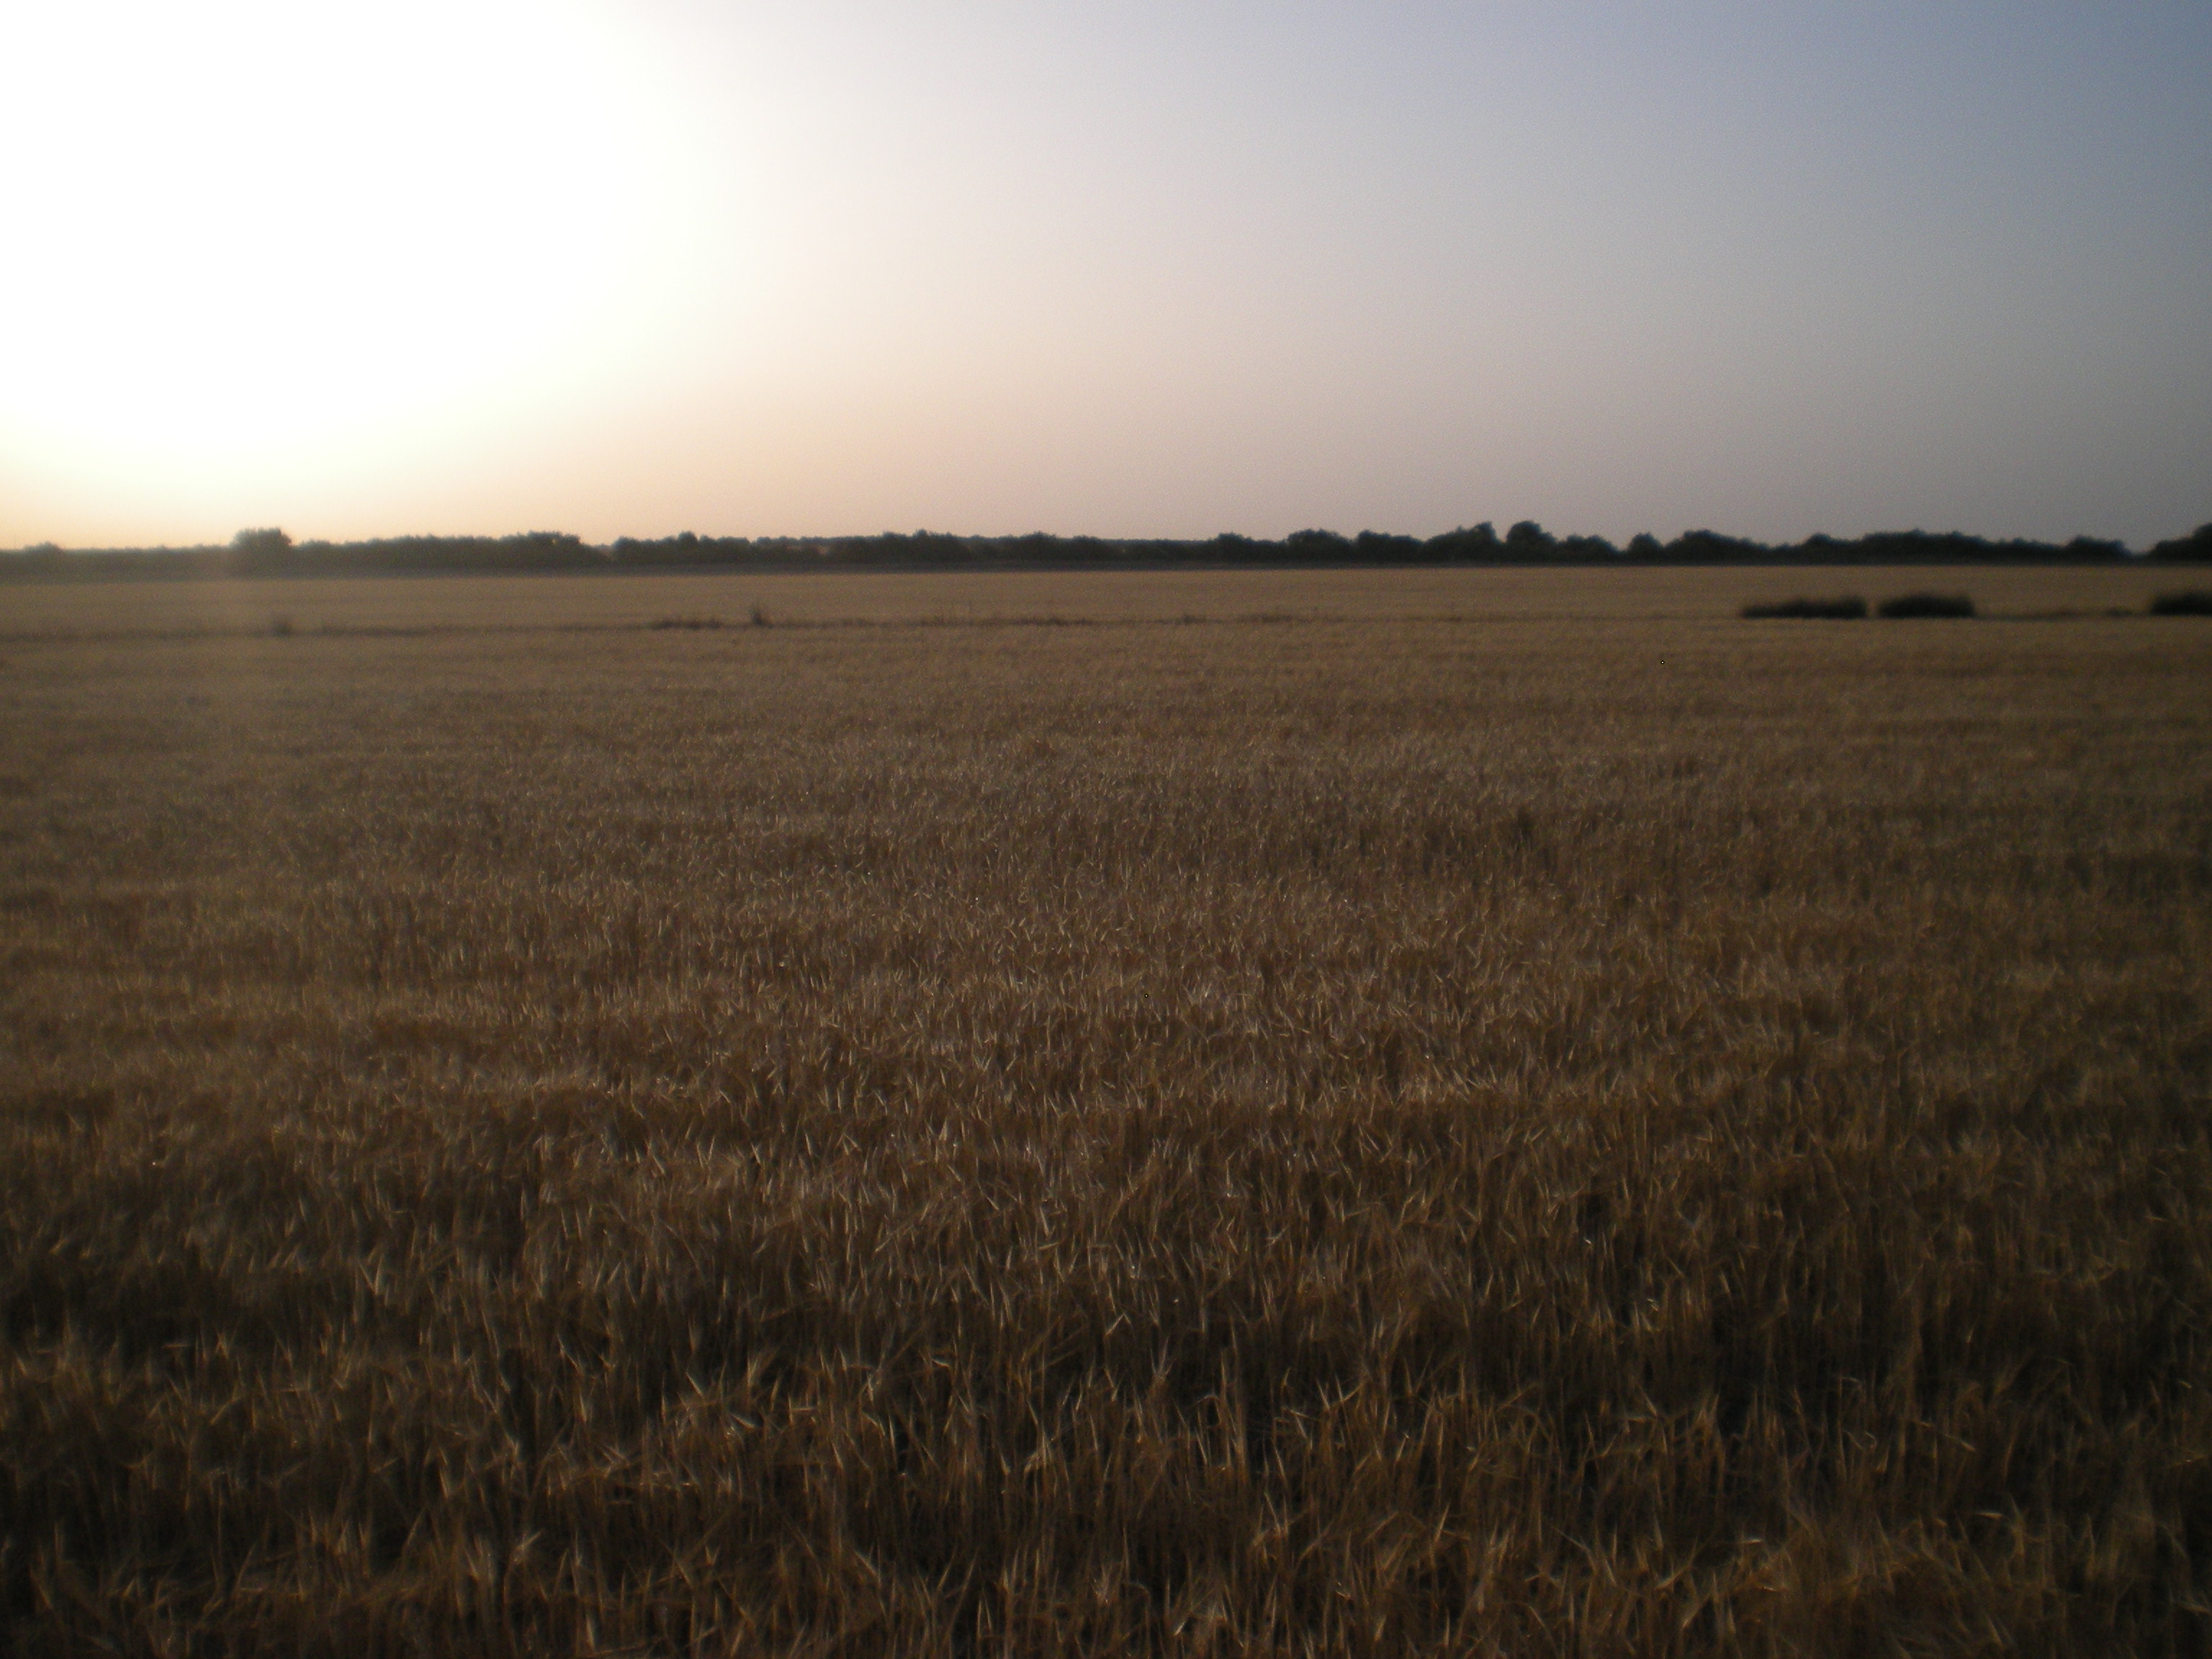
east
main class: Cropland
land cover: Barley
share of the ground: > 75 %
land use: Agriculture (excluding fallow land and kitchen gardens)
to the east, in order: Barley; Grass margins; Tracks; Grass margins; Barley
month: July
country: ES
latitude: 39.4278
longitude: -3.3210
